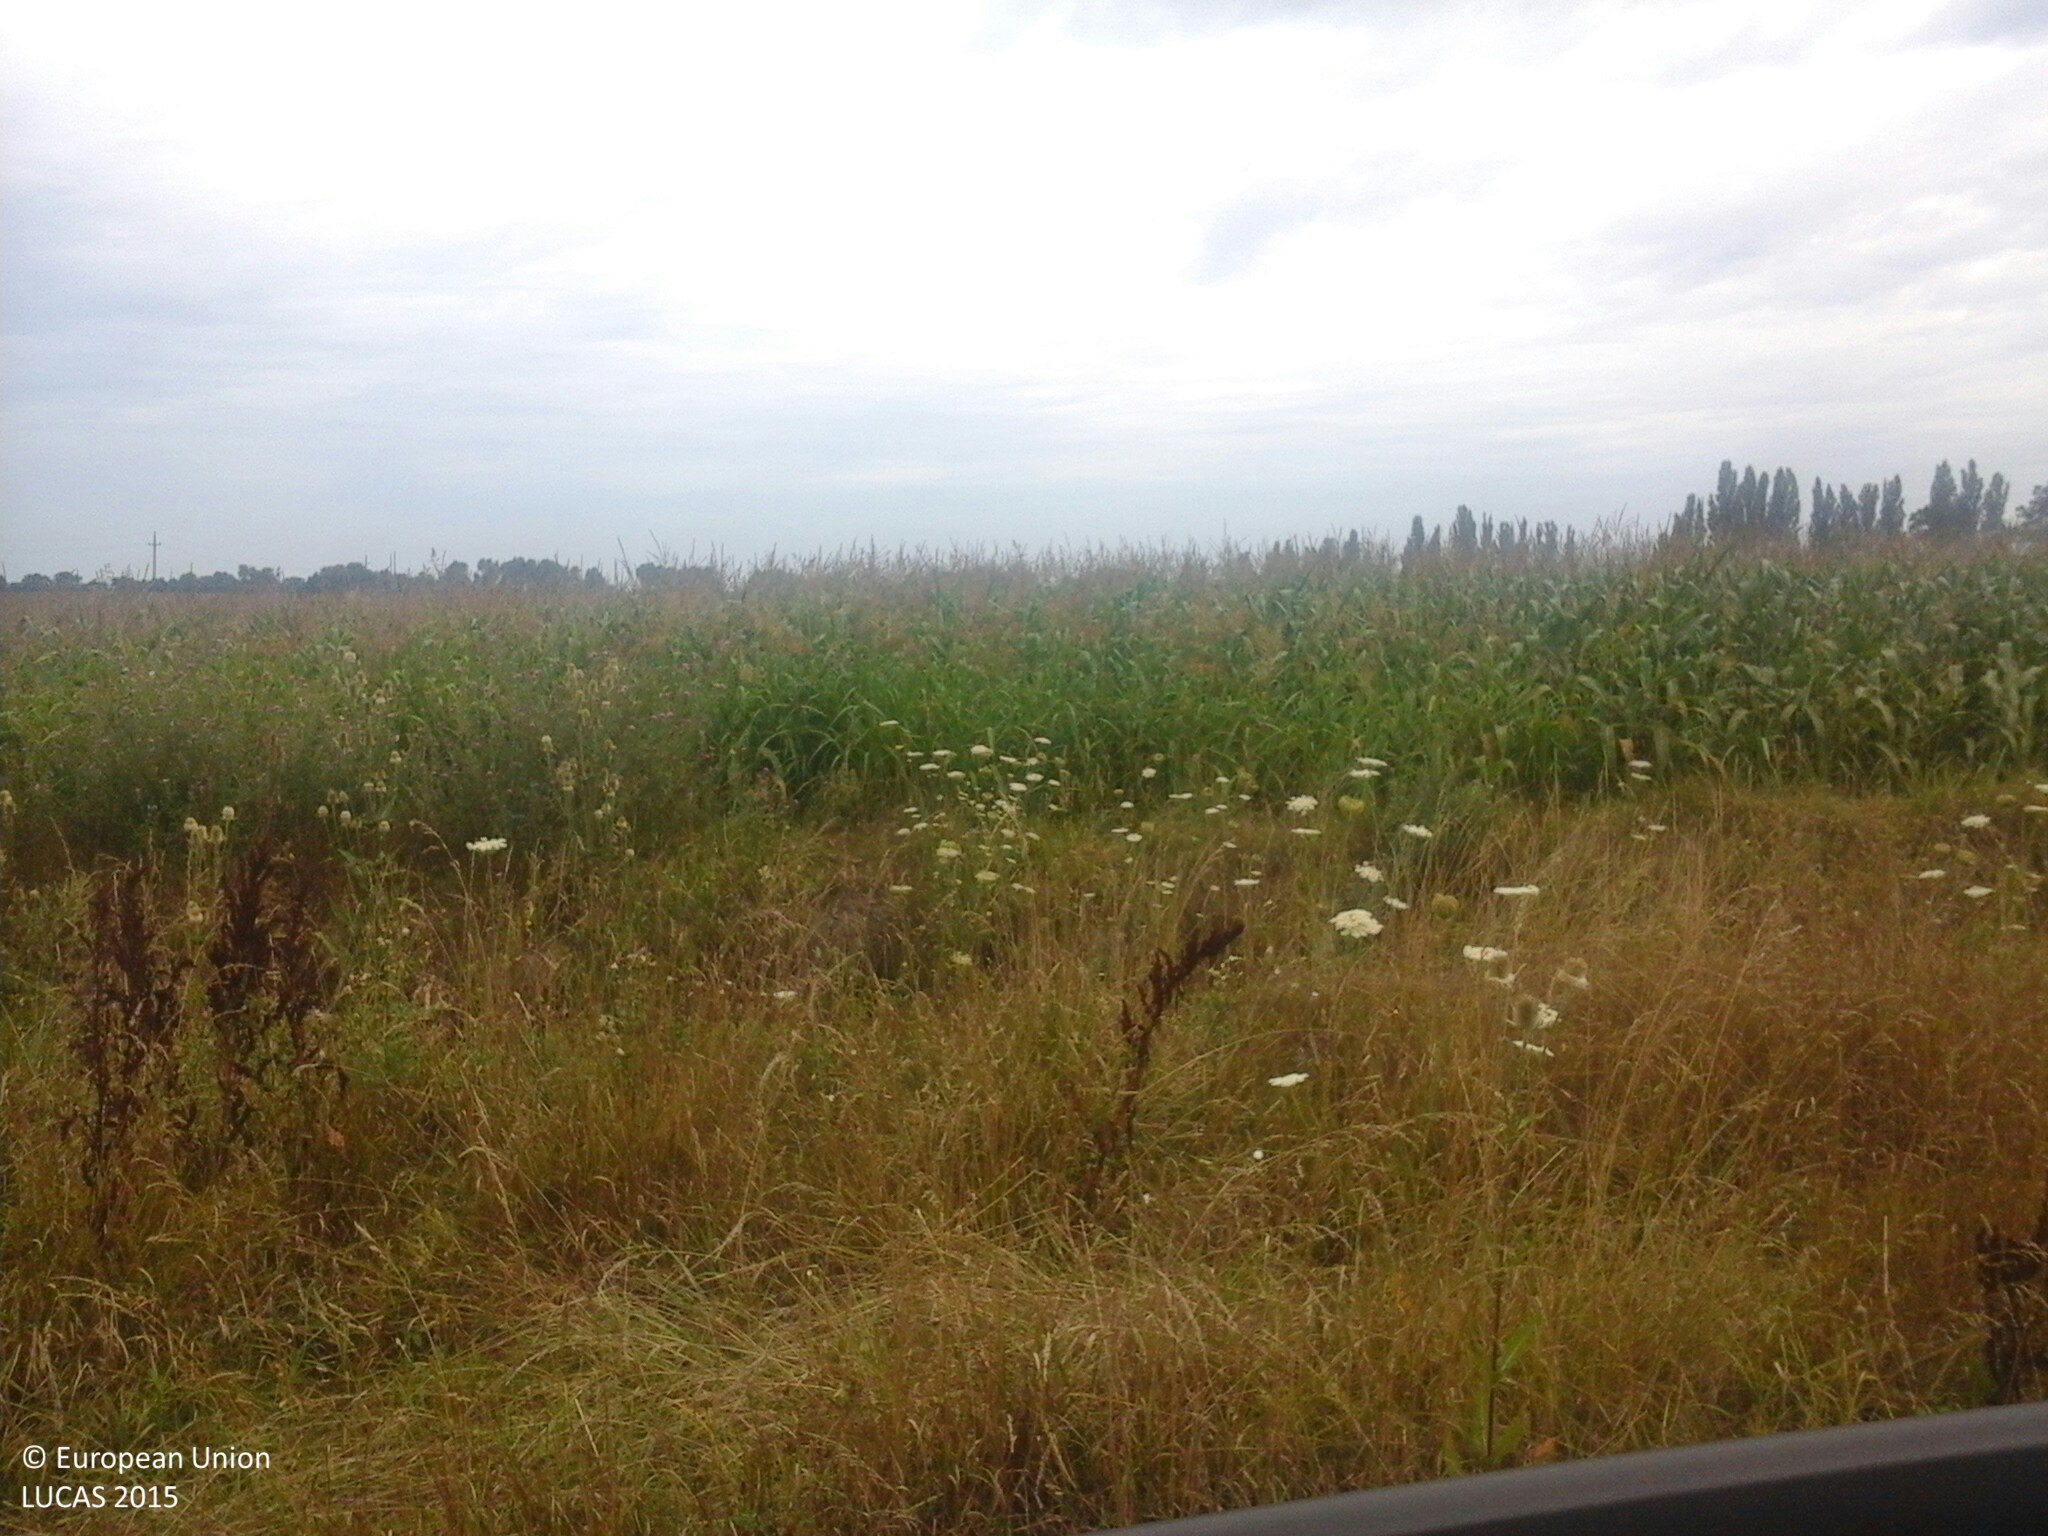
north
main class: Cropland
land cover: Sunflower
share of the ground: > 75 %
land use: Agriculture (excluding fallow land and kitchen gardens)
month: July
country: HU
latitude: 47.0503
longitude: 18.4233
